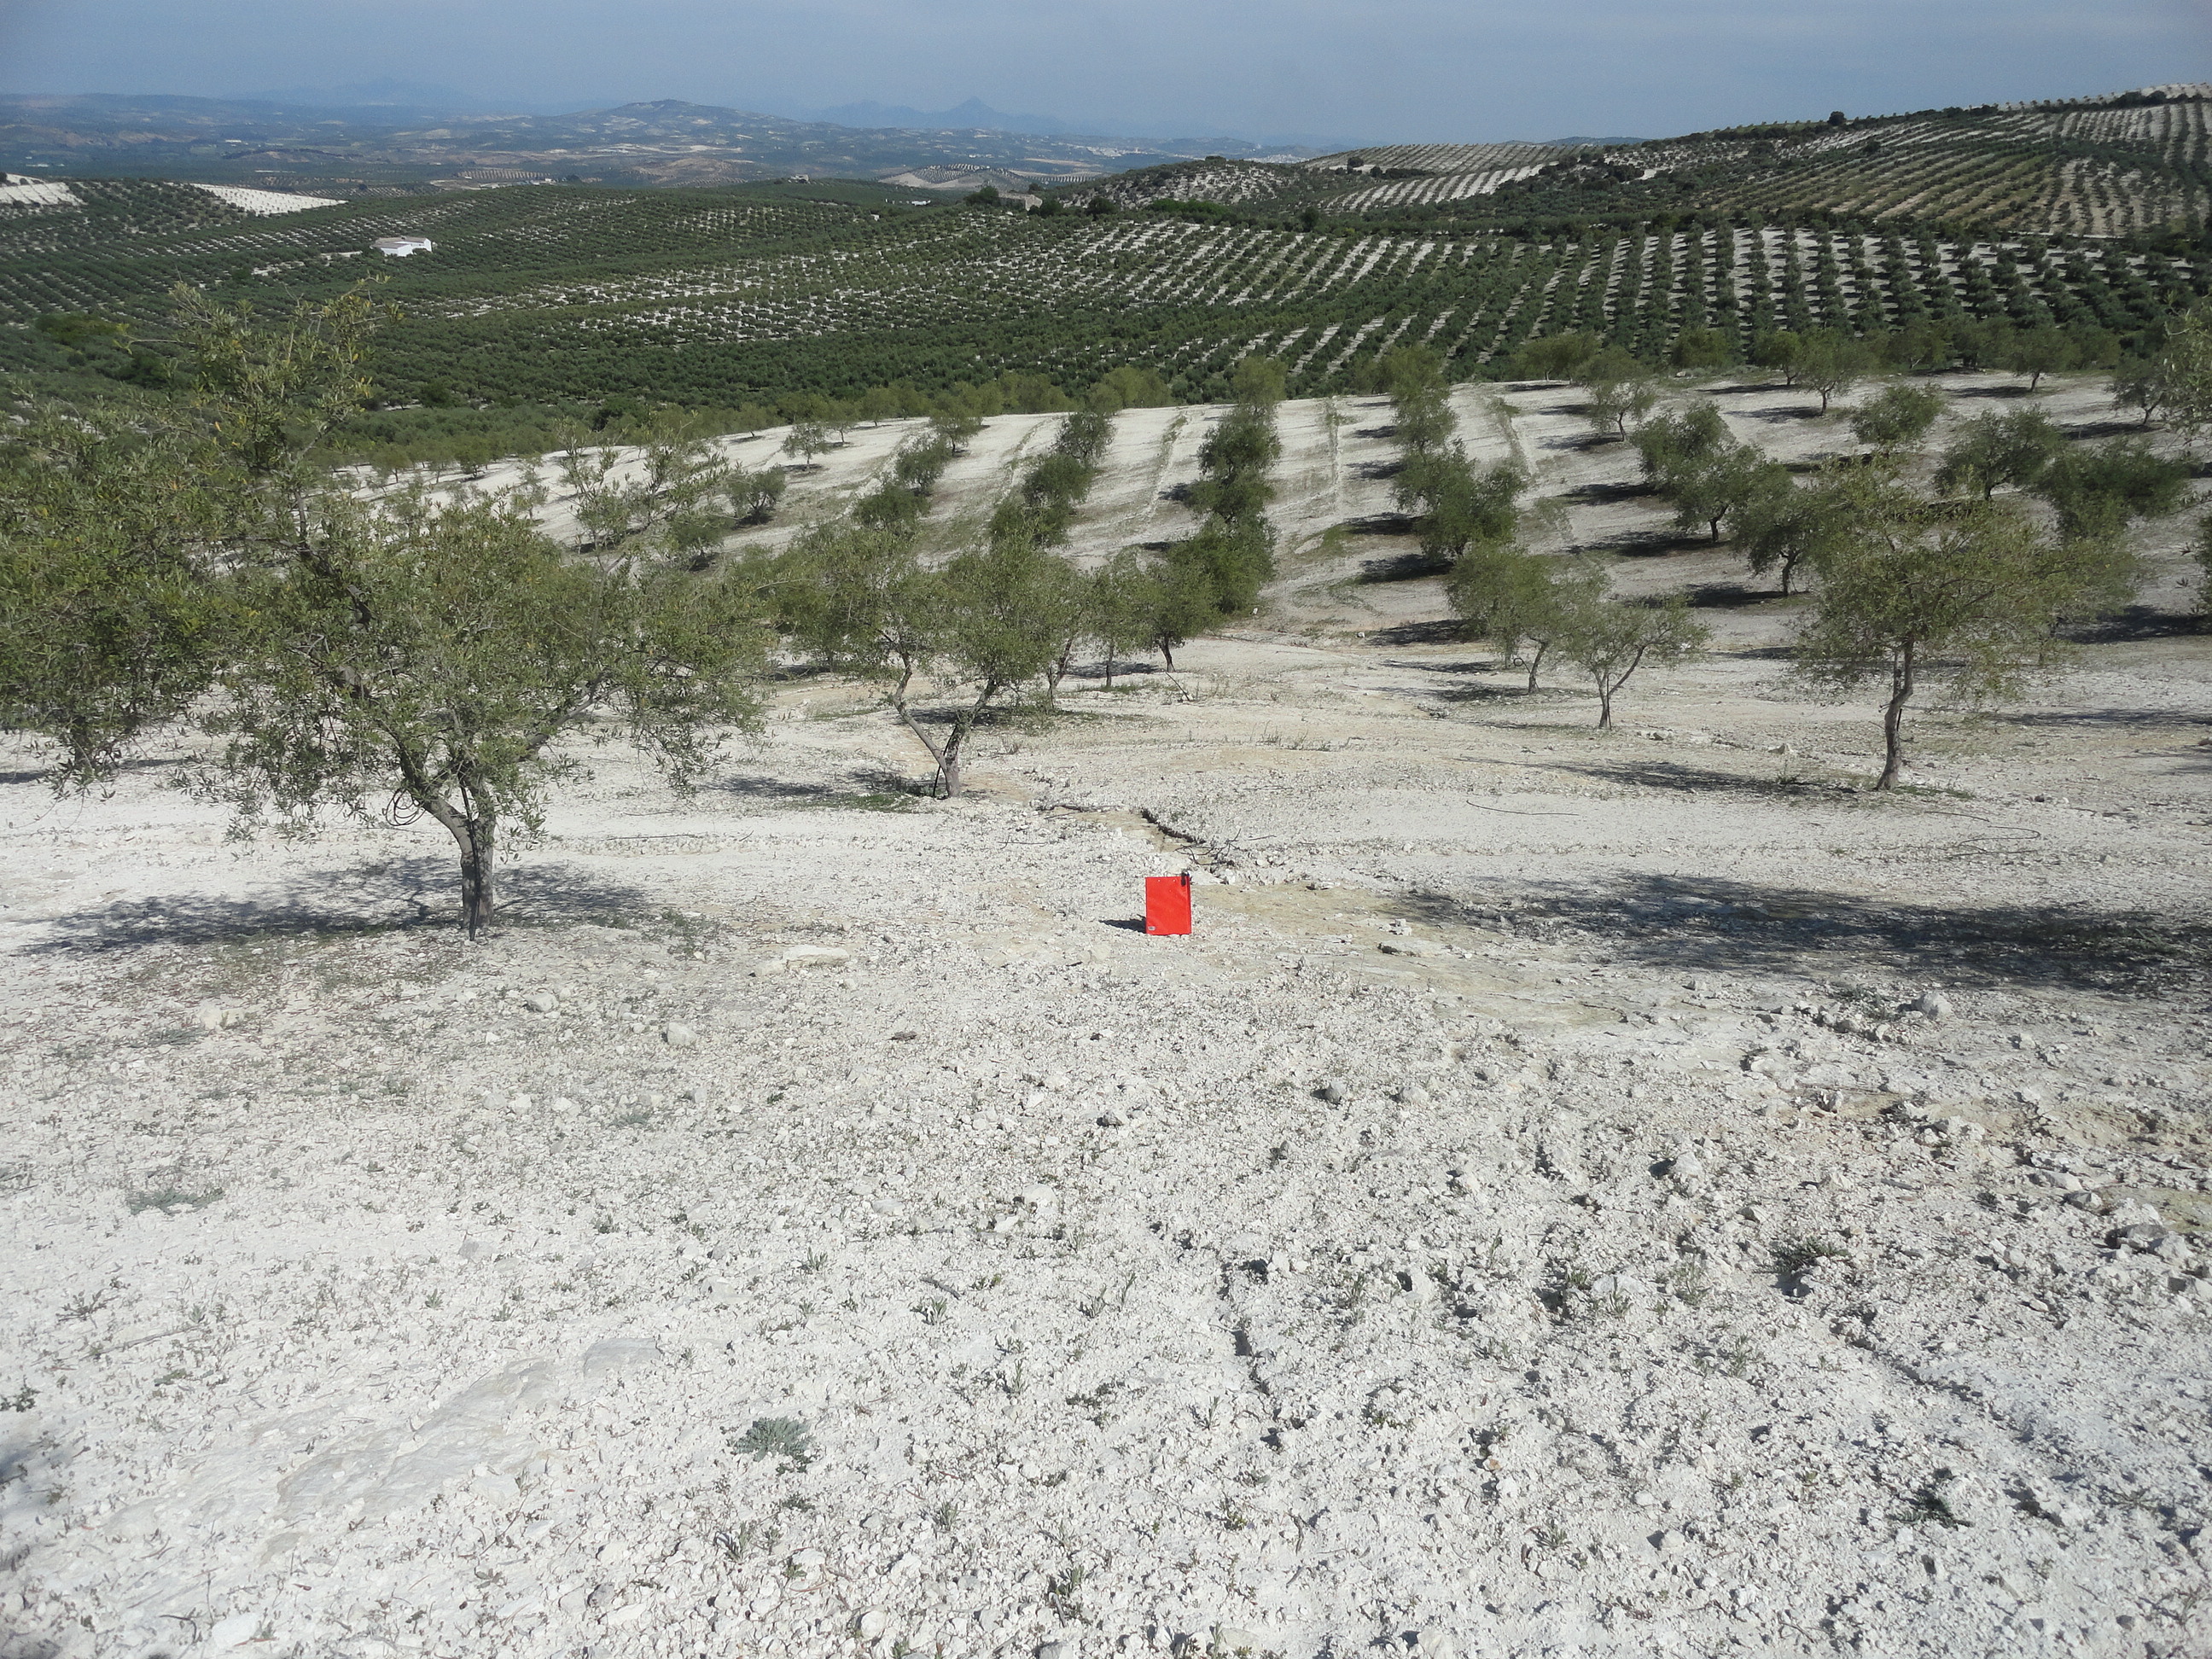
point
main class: Cropland
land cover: Olive groves
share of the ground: 25 - 50 %
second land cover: Other bare soil
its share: > 75 %
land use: Agriculture (excluding fallow land and kitchen gardens)
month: April
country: ES
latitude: 37.6477
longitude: -4.4570
